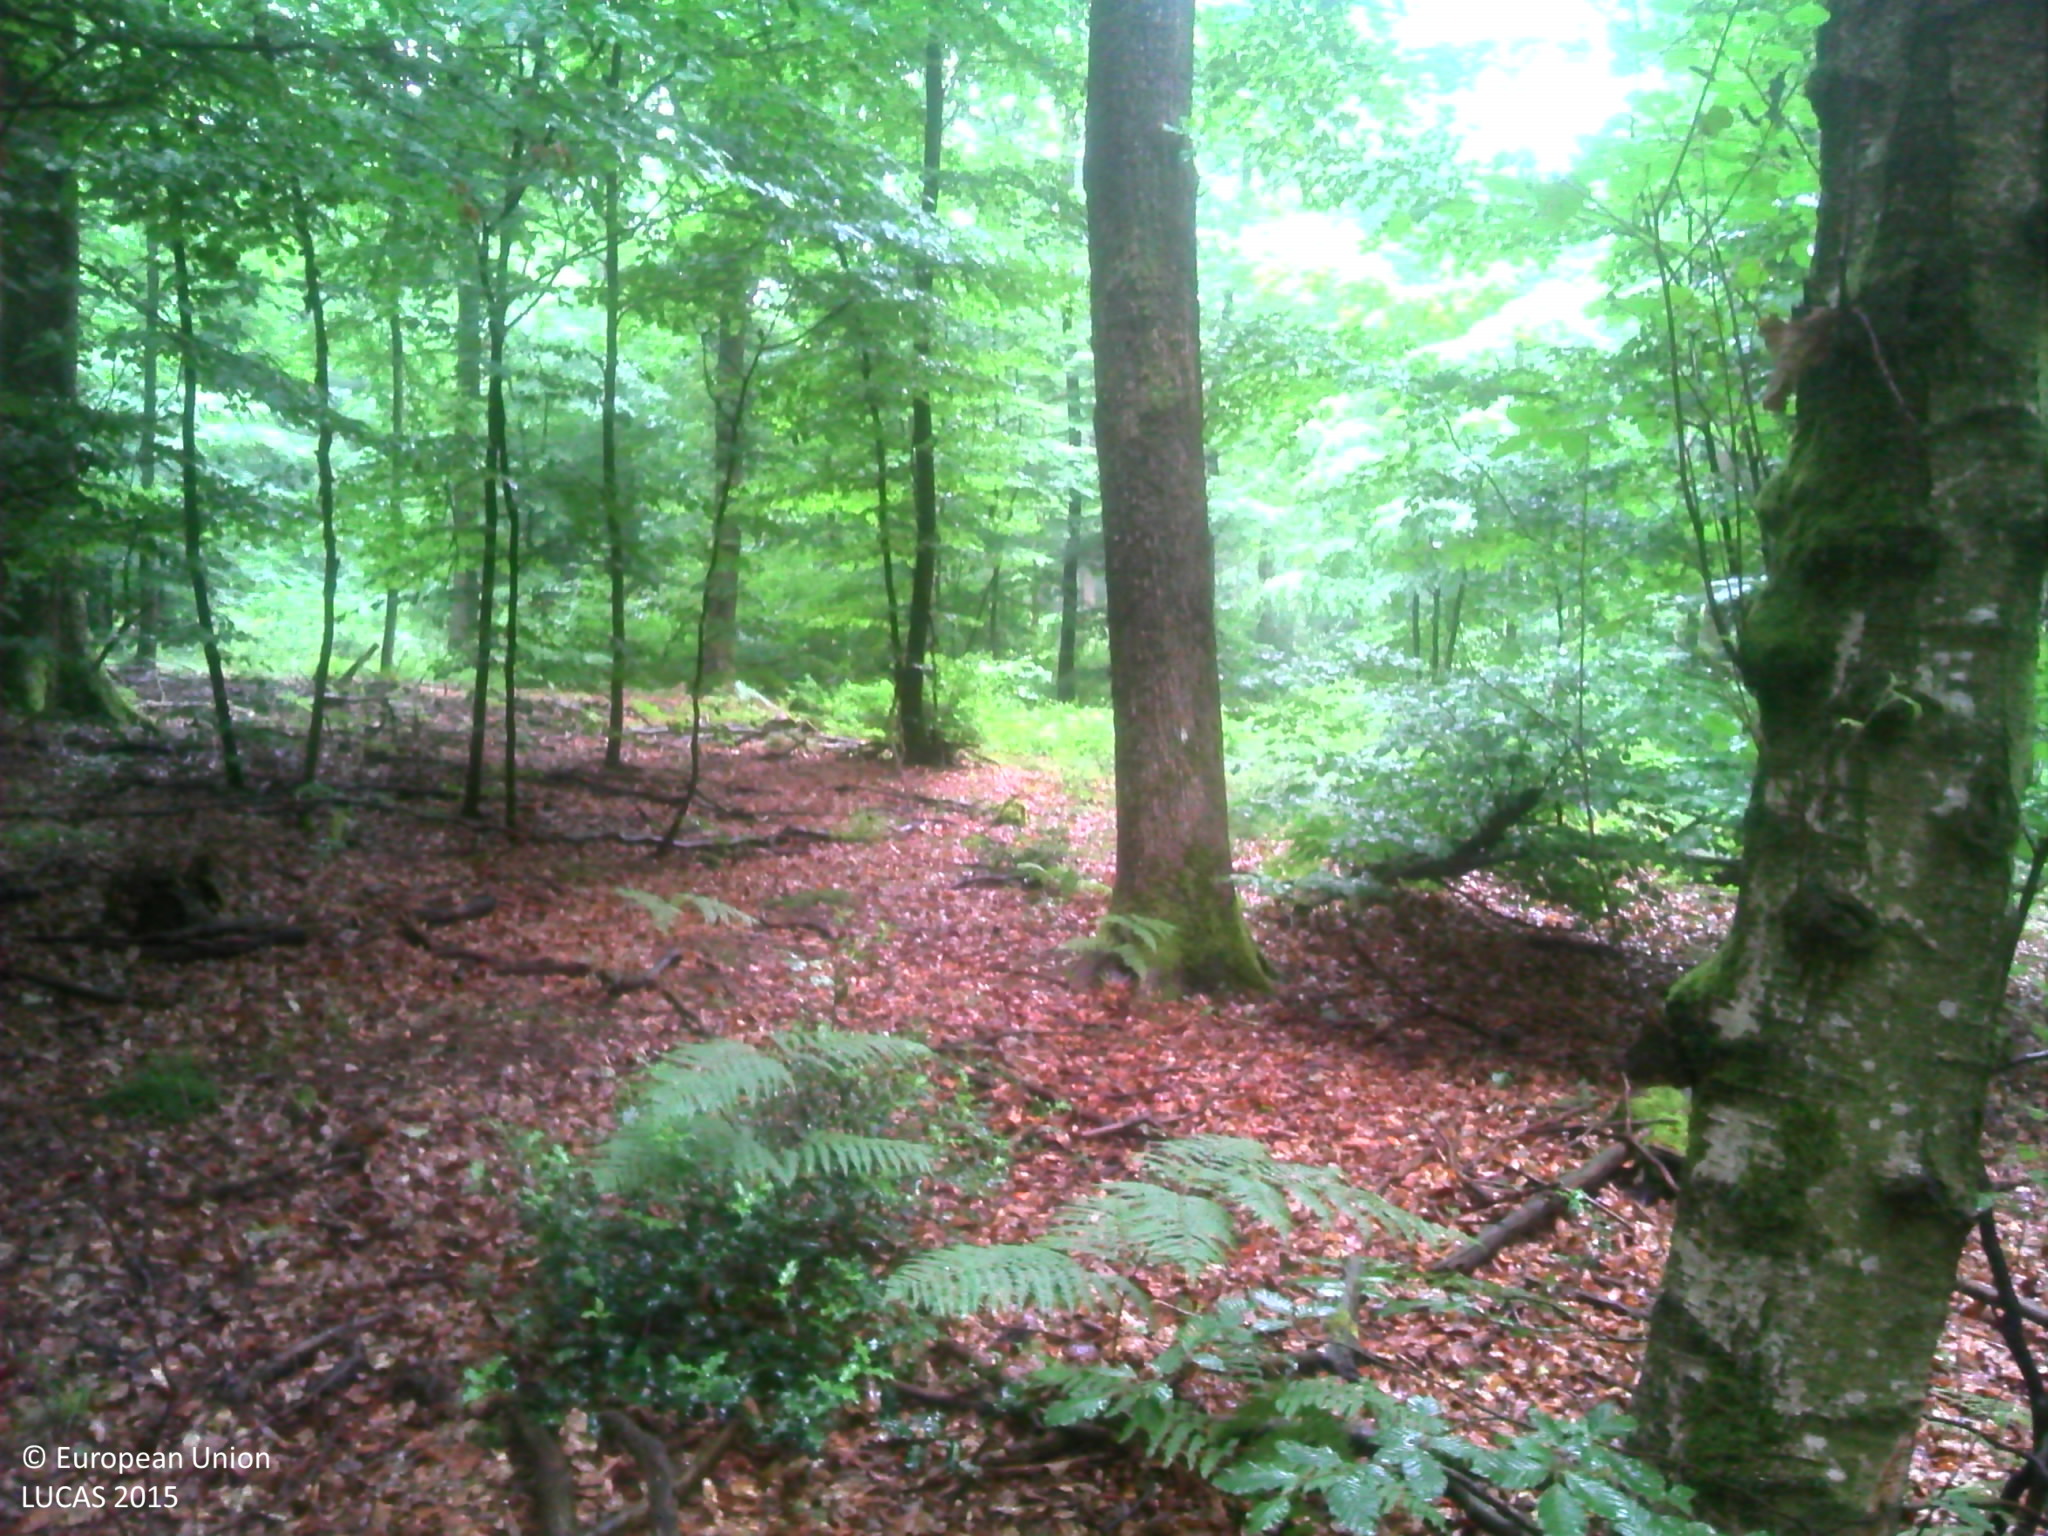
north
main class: Woodland
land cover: Broadleaved woodland
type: acidophilous oak and oak-birch forest
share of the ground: > 75 %
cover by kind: broadleaved forest trees 100 %
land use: Forestry
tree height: > 5 m
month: July
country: BE
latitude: 50.0419
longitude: 4.6765
